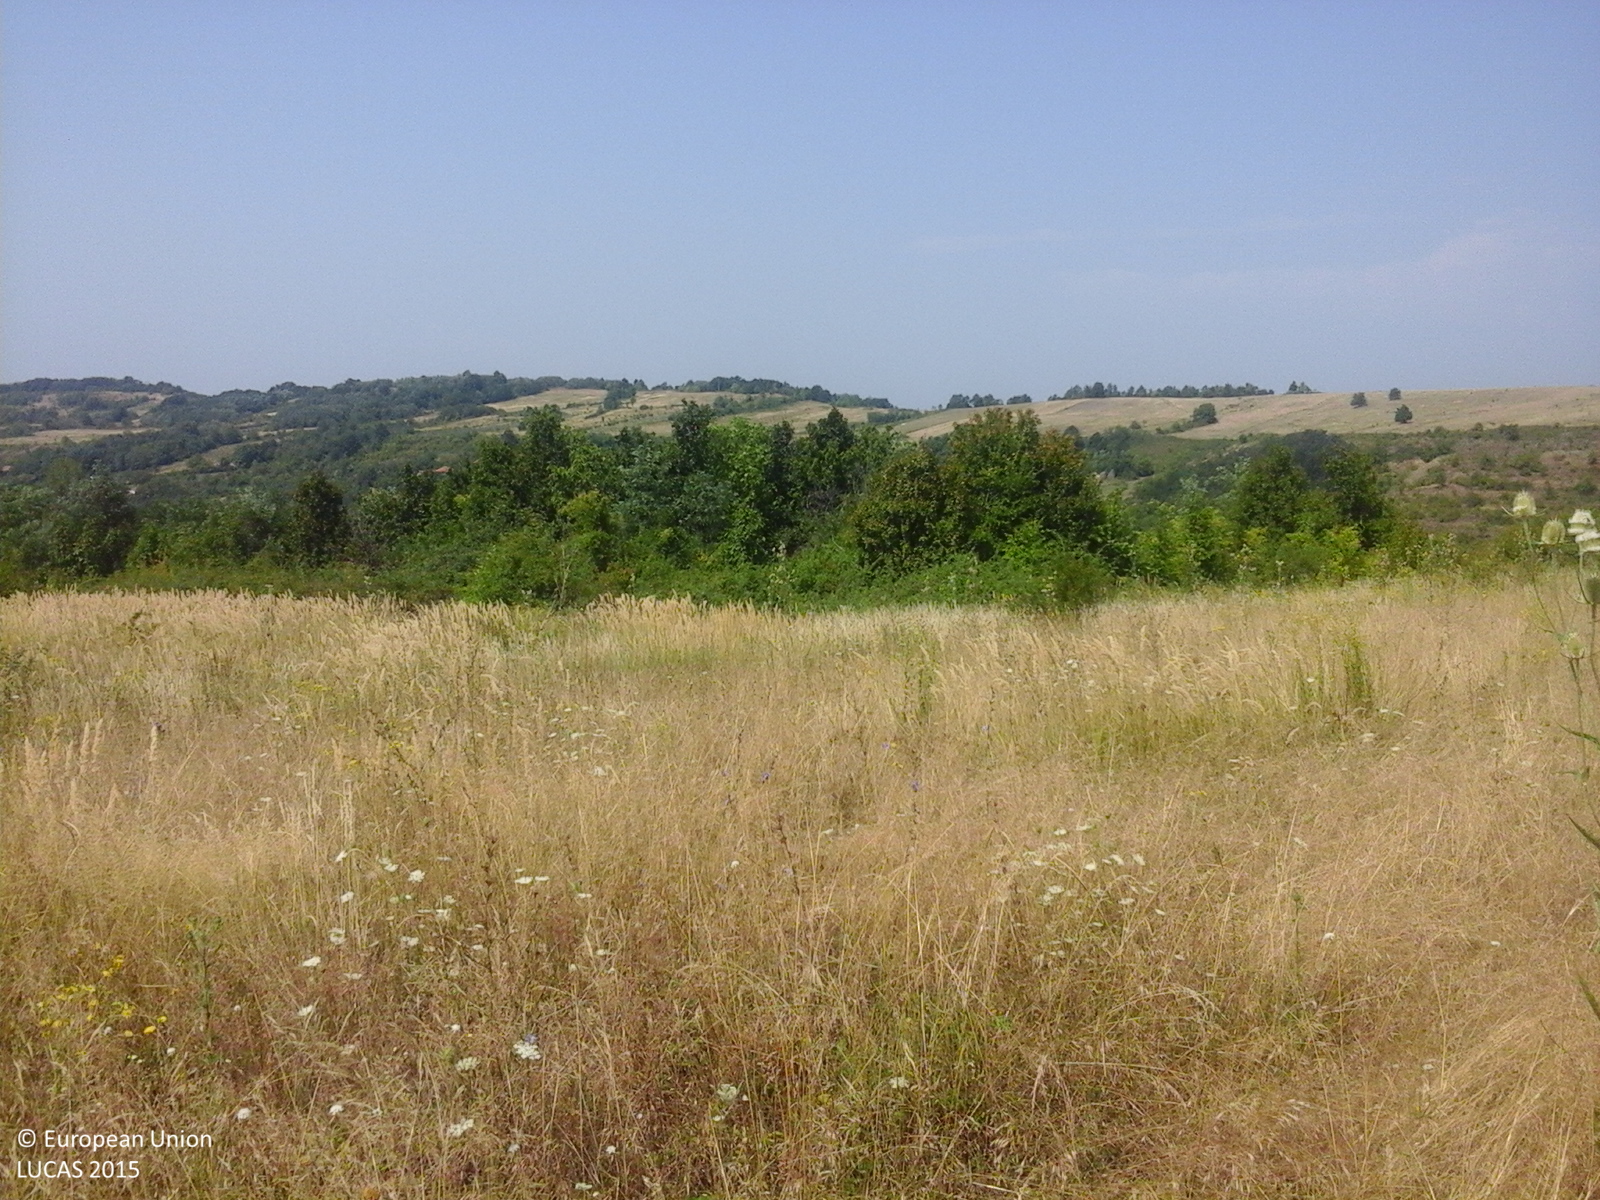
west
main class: Grassland
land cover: Grassland without tree/shrub cover
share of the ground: > 75 %
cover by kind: herbaceous plants 100 %
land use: Agriculture (excluding fallow land and kitchen gardens)
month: August
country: RO
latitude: 44.5738
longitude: 23.1065
